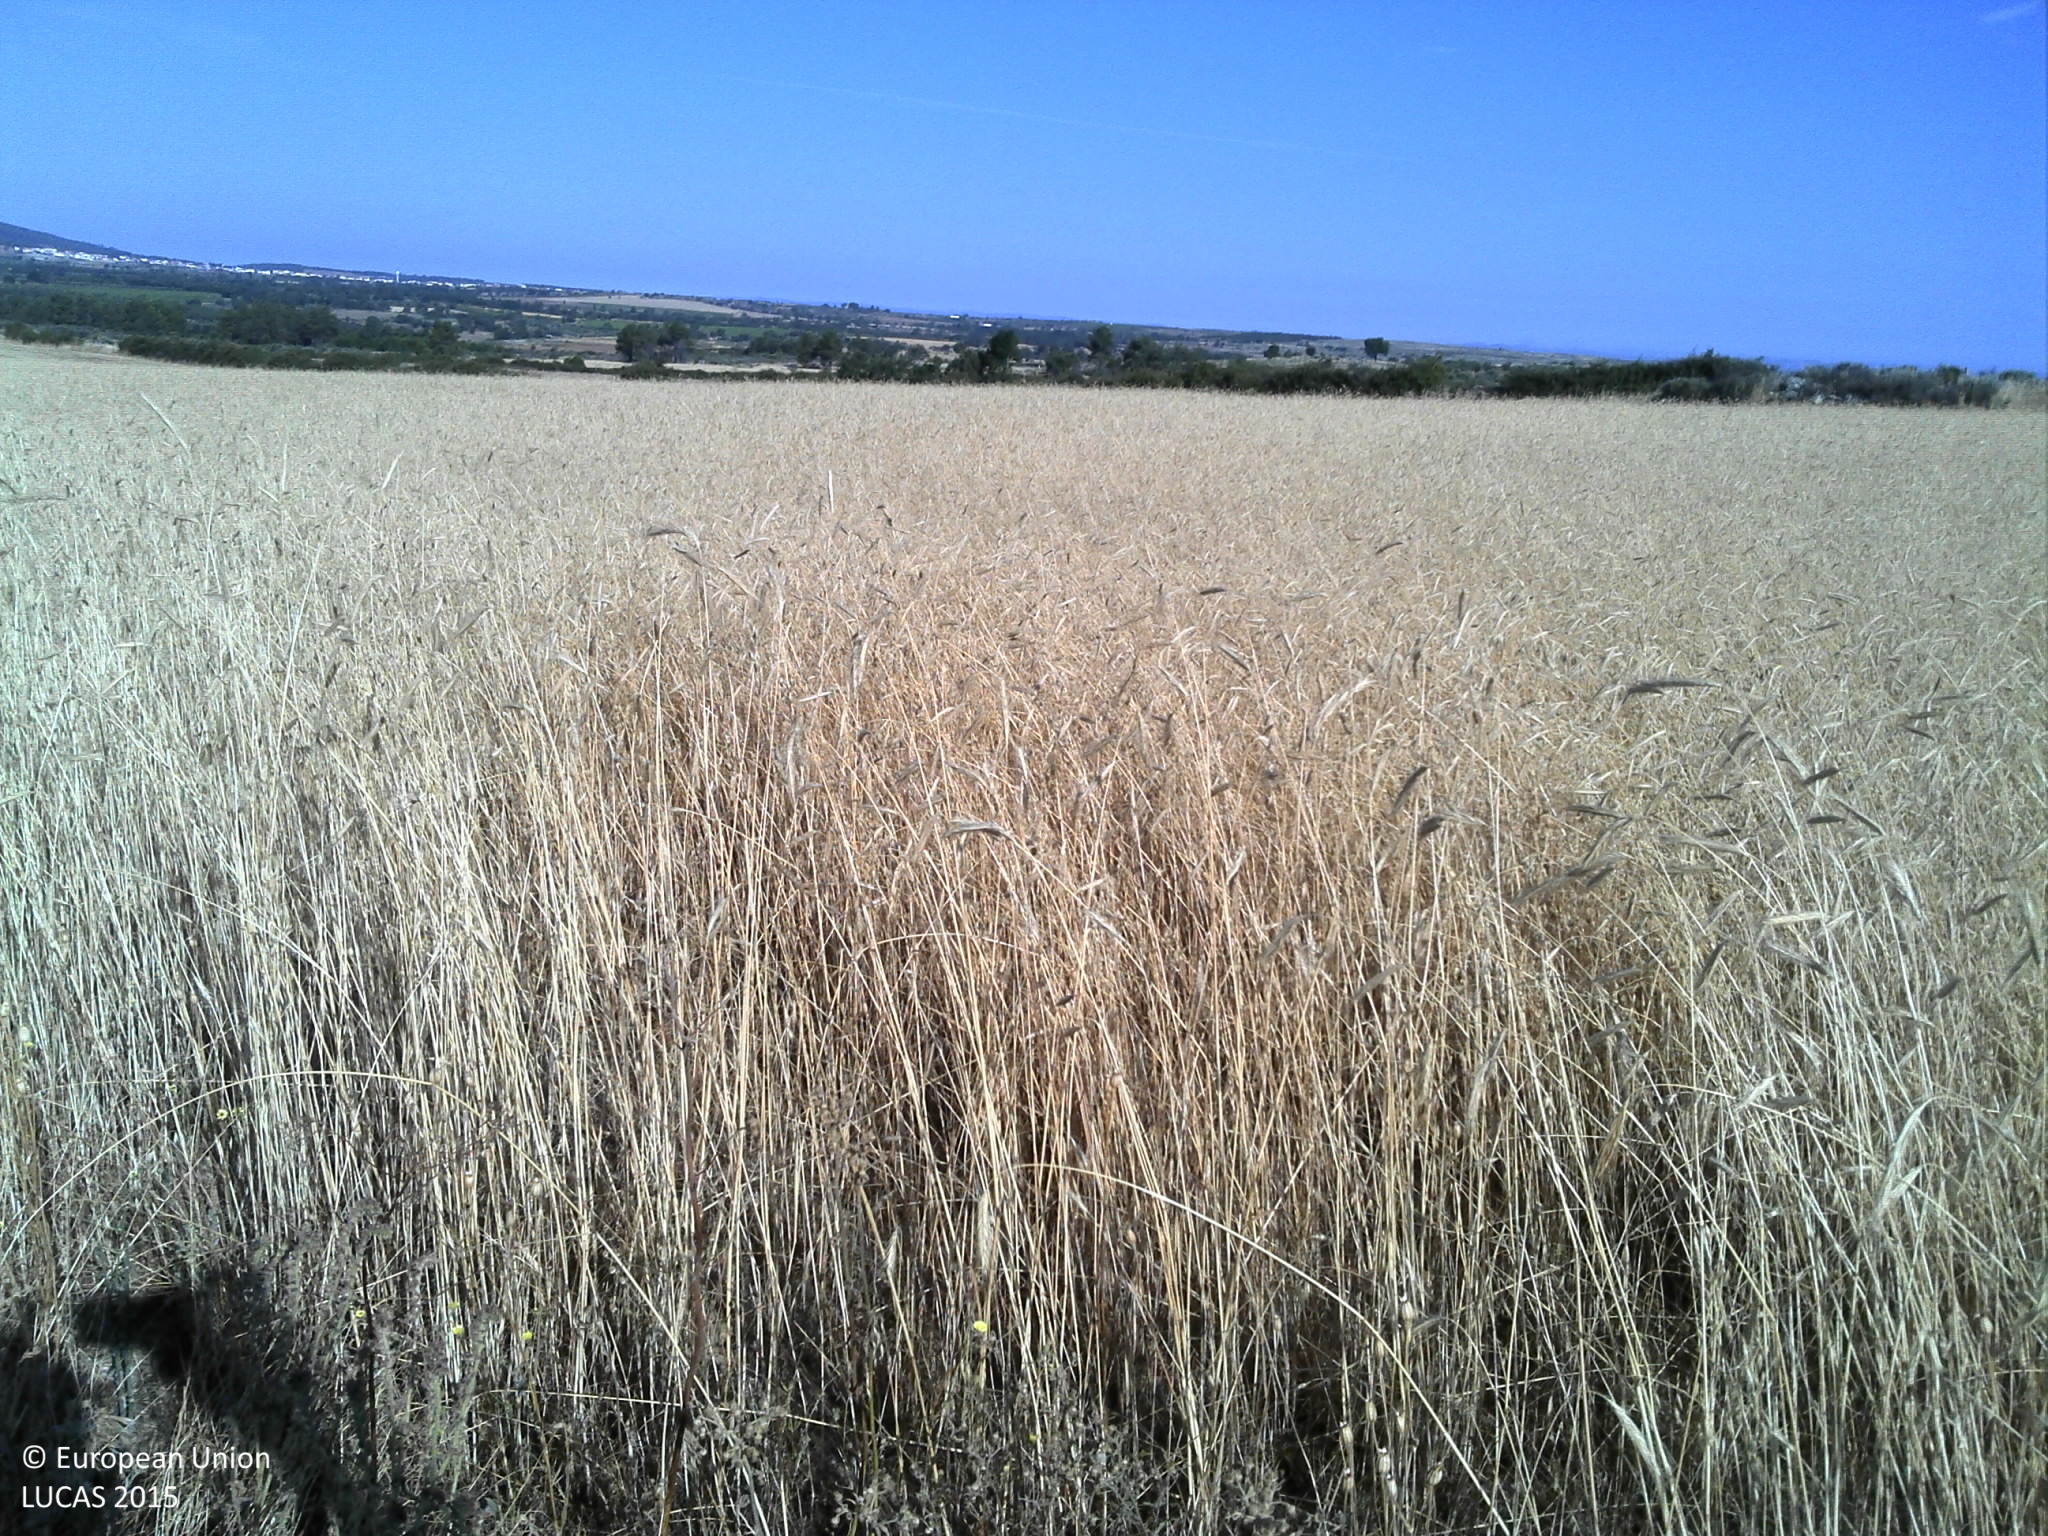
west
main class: Cropland
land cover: Barley
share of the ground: > 75 %
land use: Agriculture (excluding fallow land and kitchen gardens)
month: June
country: PT
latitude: 40.8907
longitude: -6.8972
